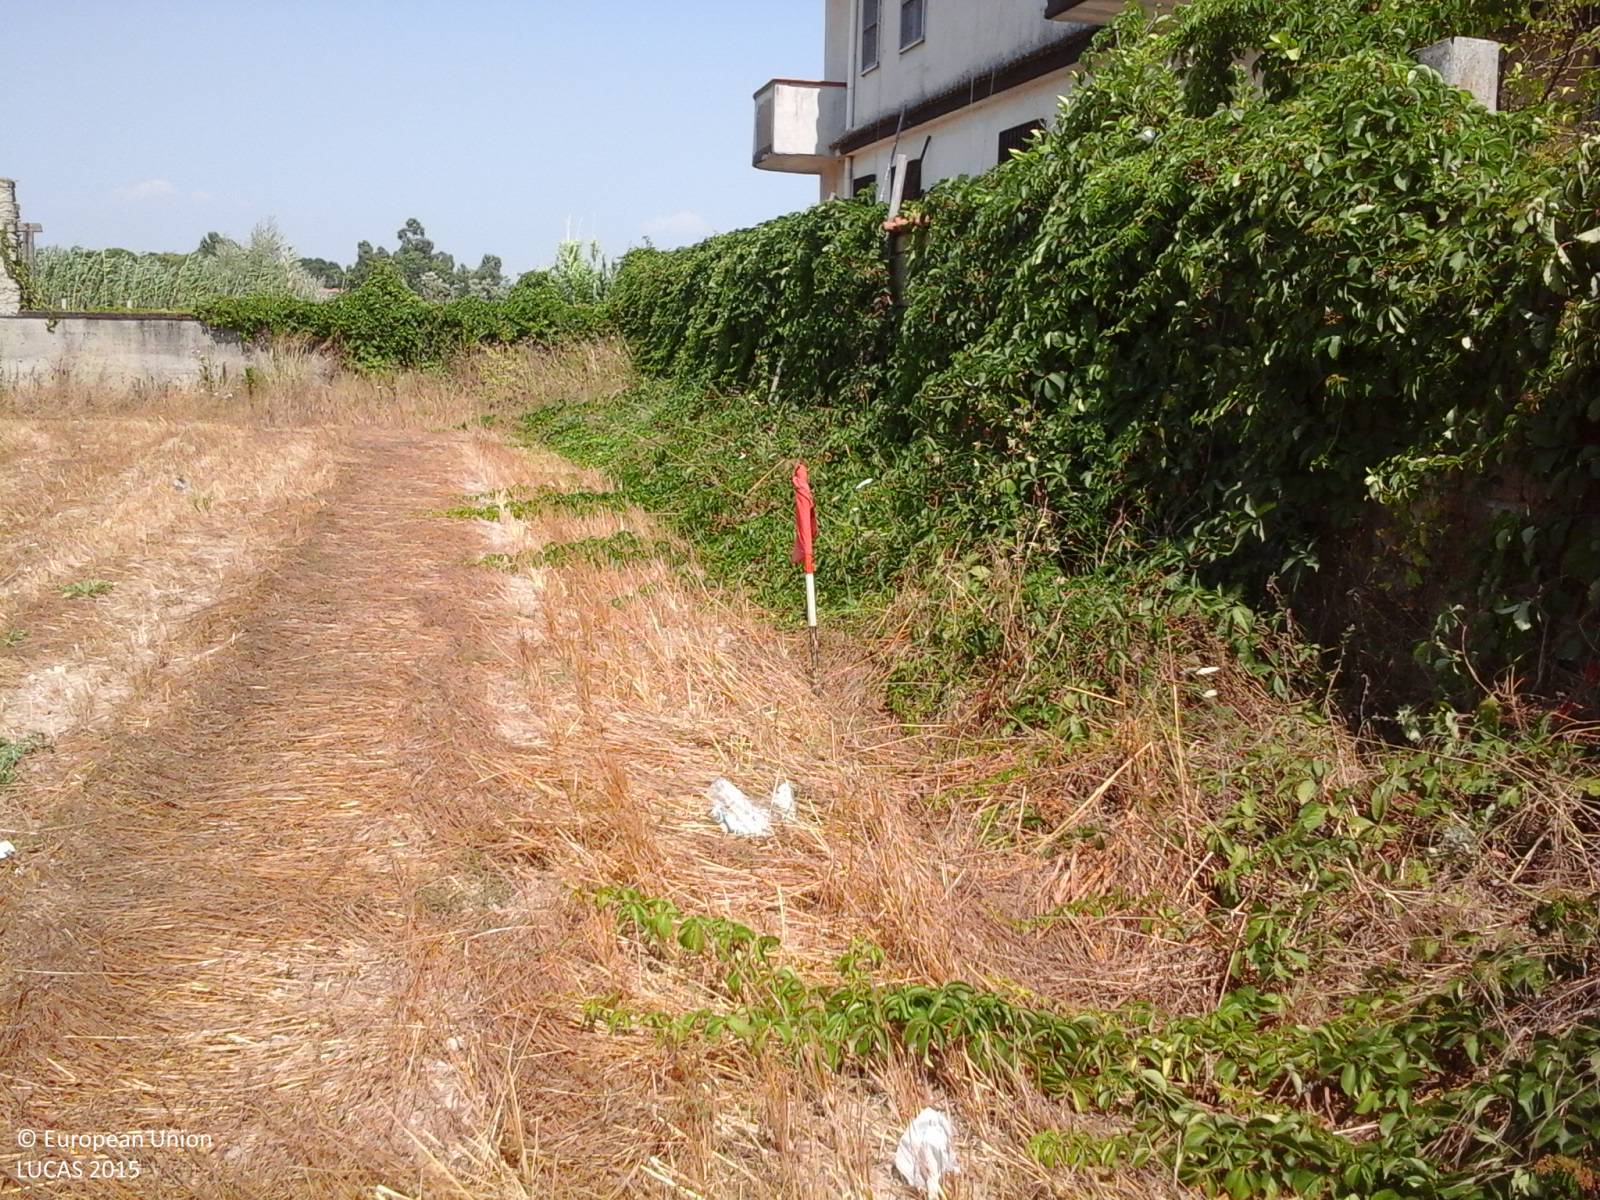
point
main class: Cropland
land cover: Oats
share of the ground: < 10 %
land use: Agriculture (excluding fallow land and kitchen gardens)
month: July
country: IT
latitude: 40.9832
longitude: 13.9889
